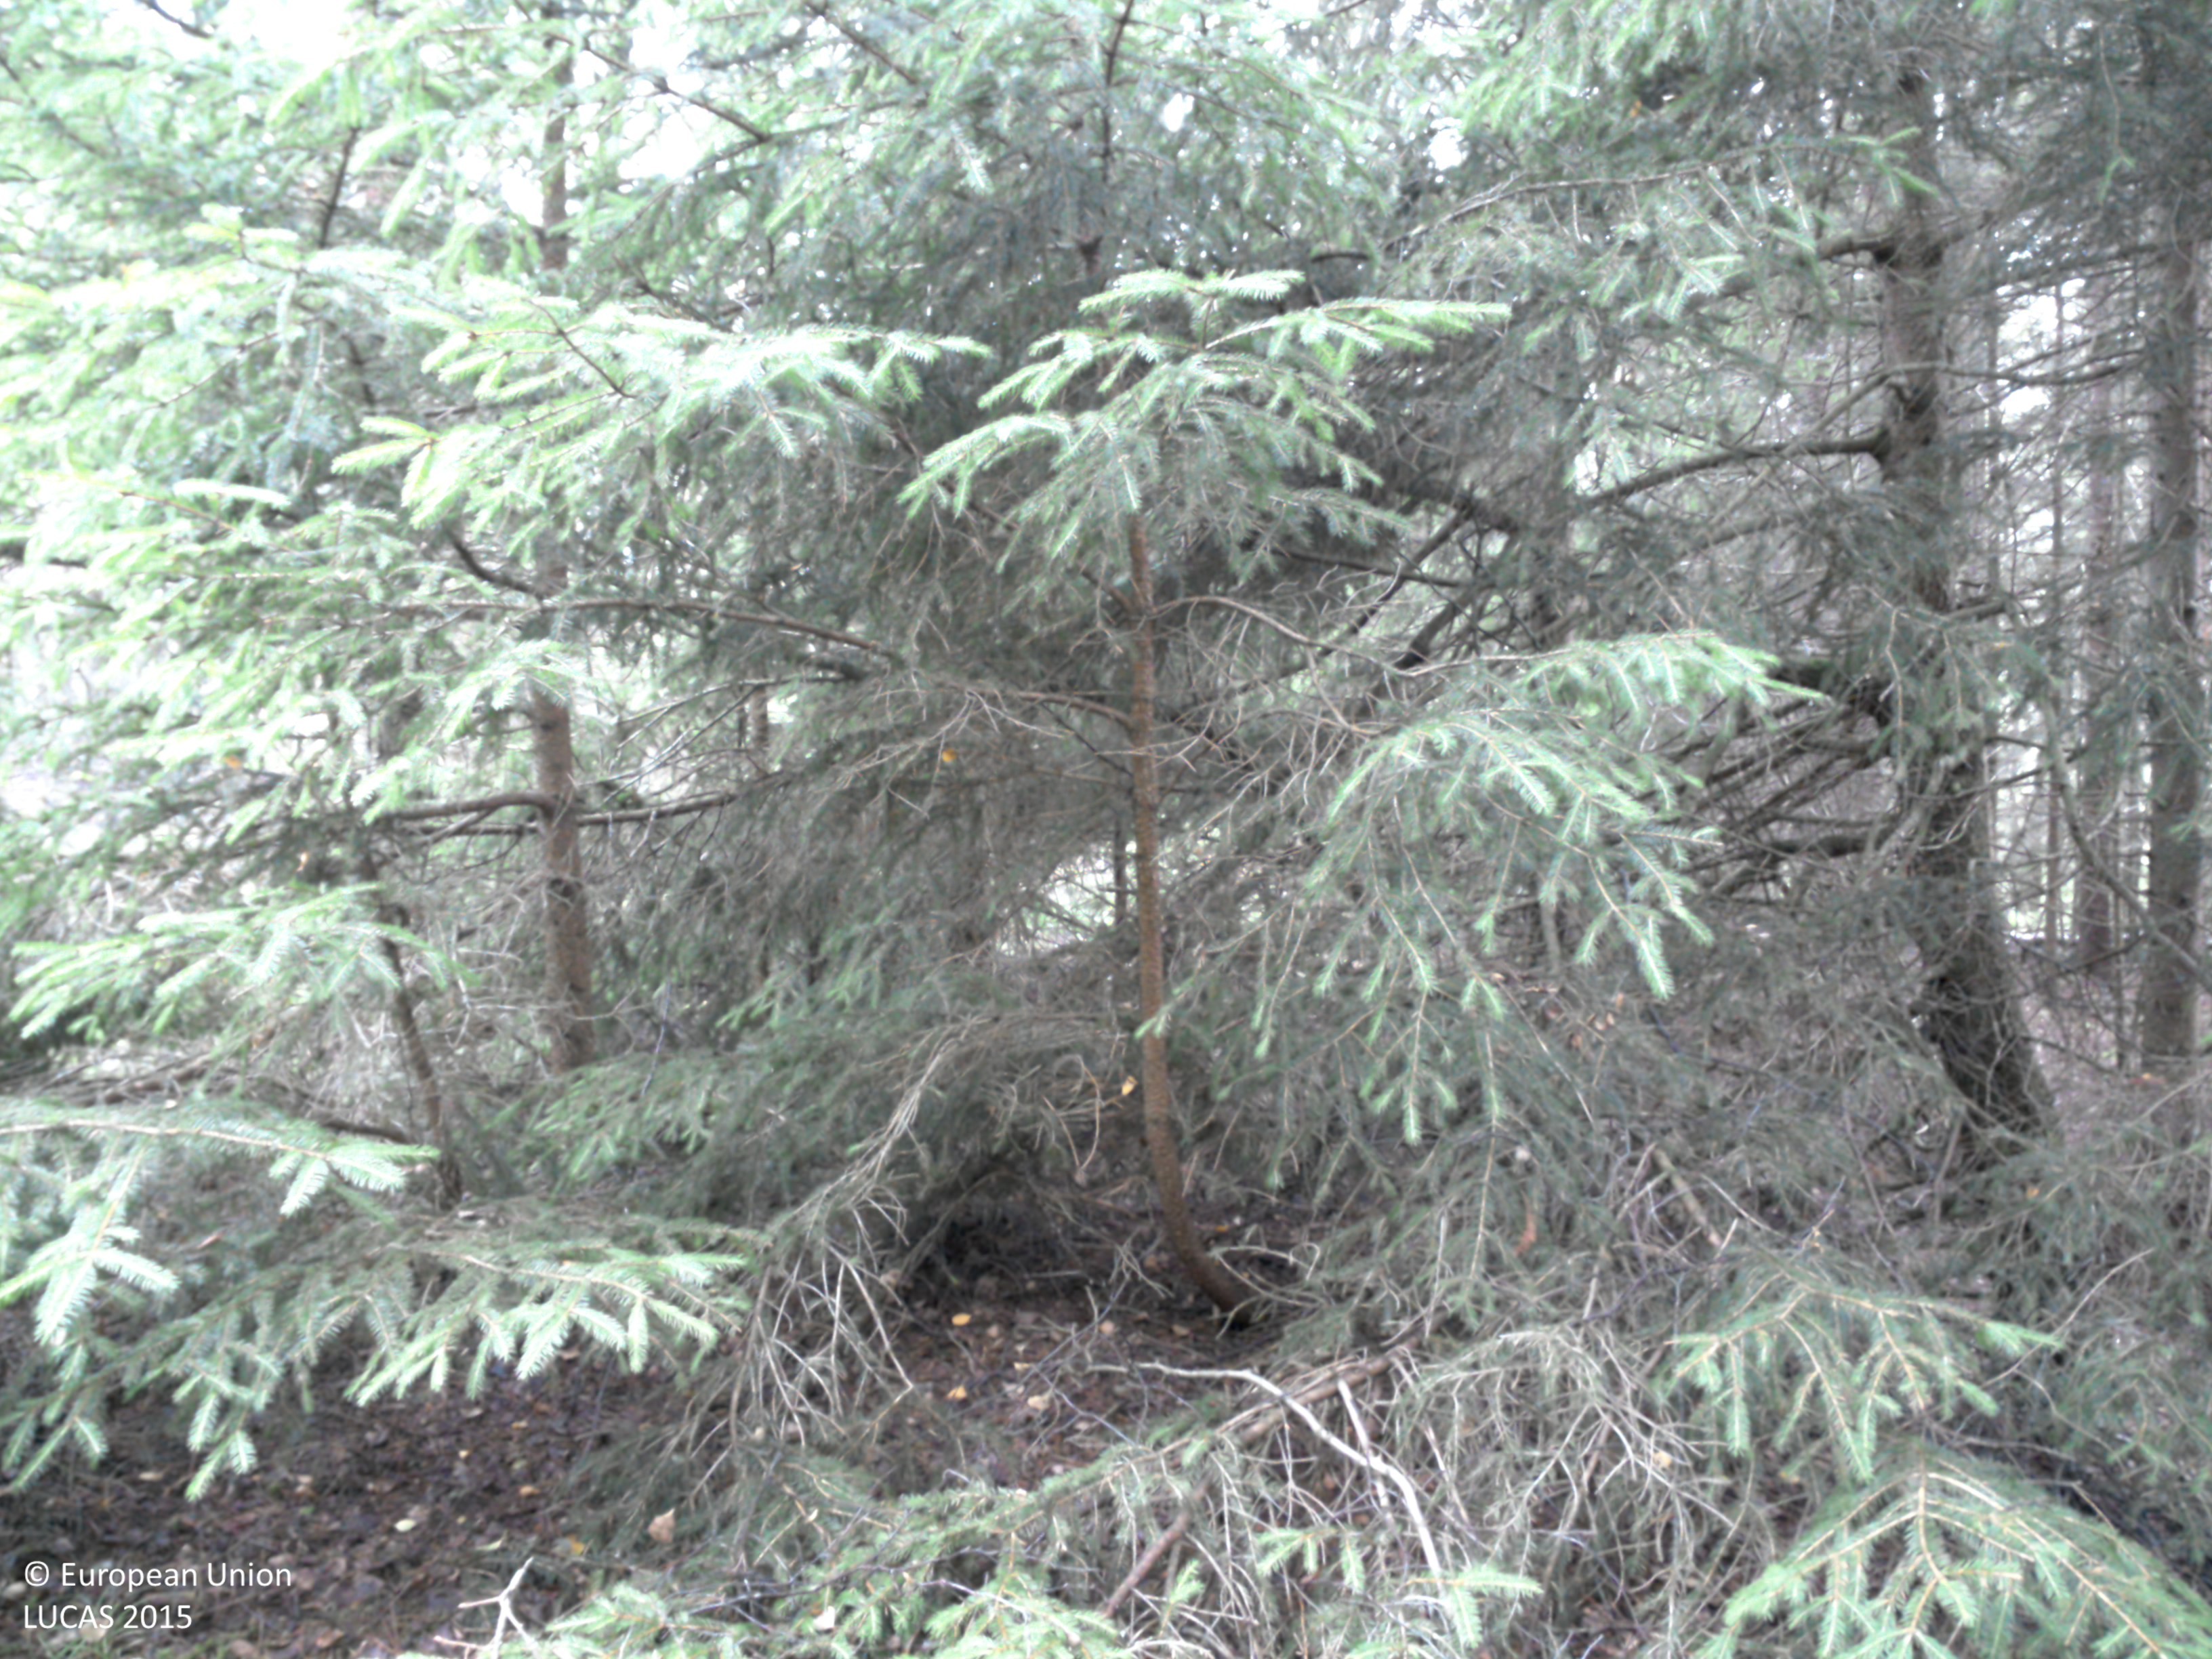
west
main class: Woodland
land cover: Spruce dominated mixed woodland
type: boreal forest
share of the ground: 50 - 75 %
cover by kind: coniferous forest trees 50 %, broadleaved forest trees 20 %, lichens and mosses 20 %, herbaceous plants 10 %
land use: Forestry
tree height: > 5 m
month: July
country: SE
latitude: 58.0116
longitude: 11.6386
